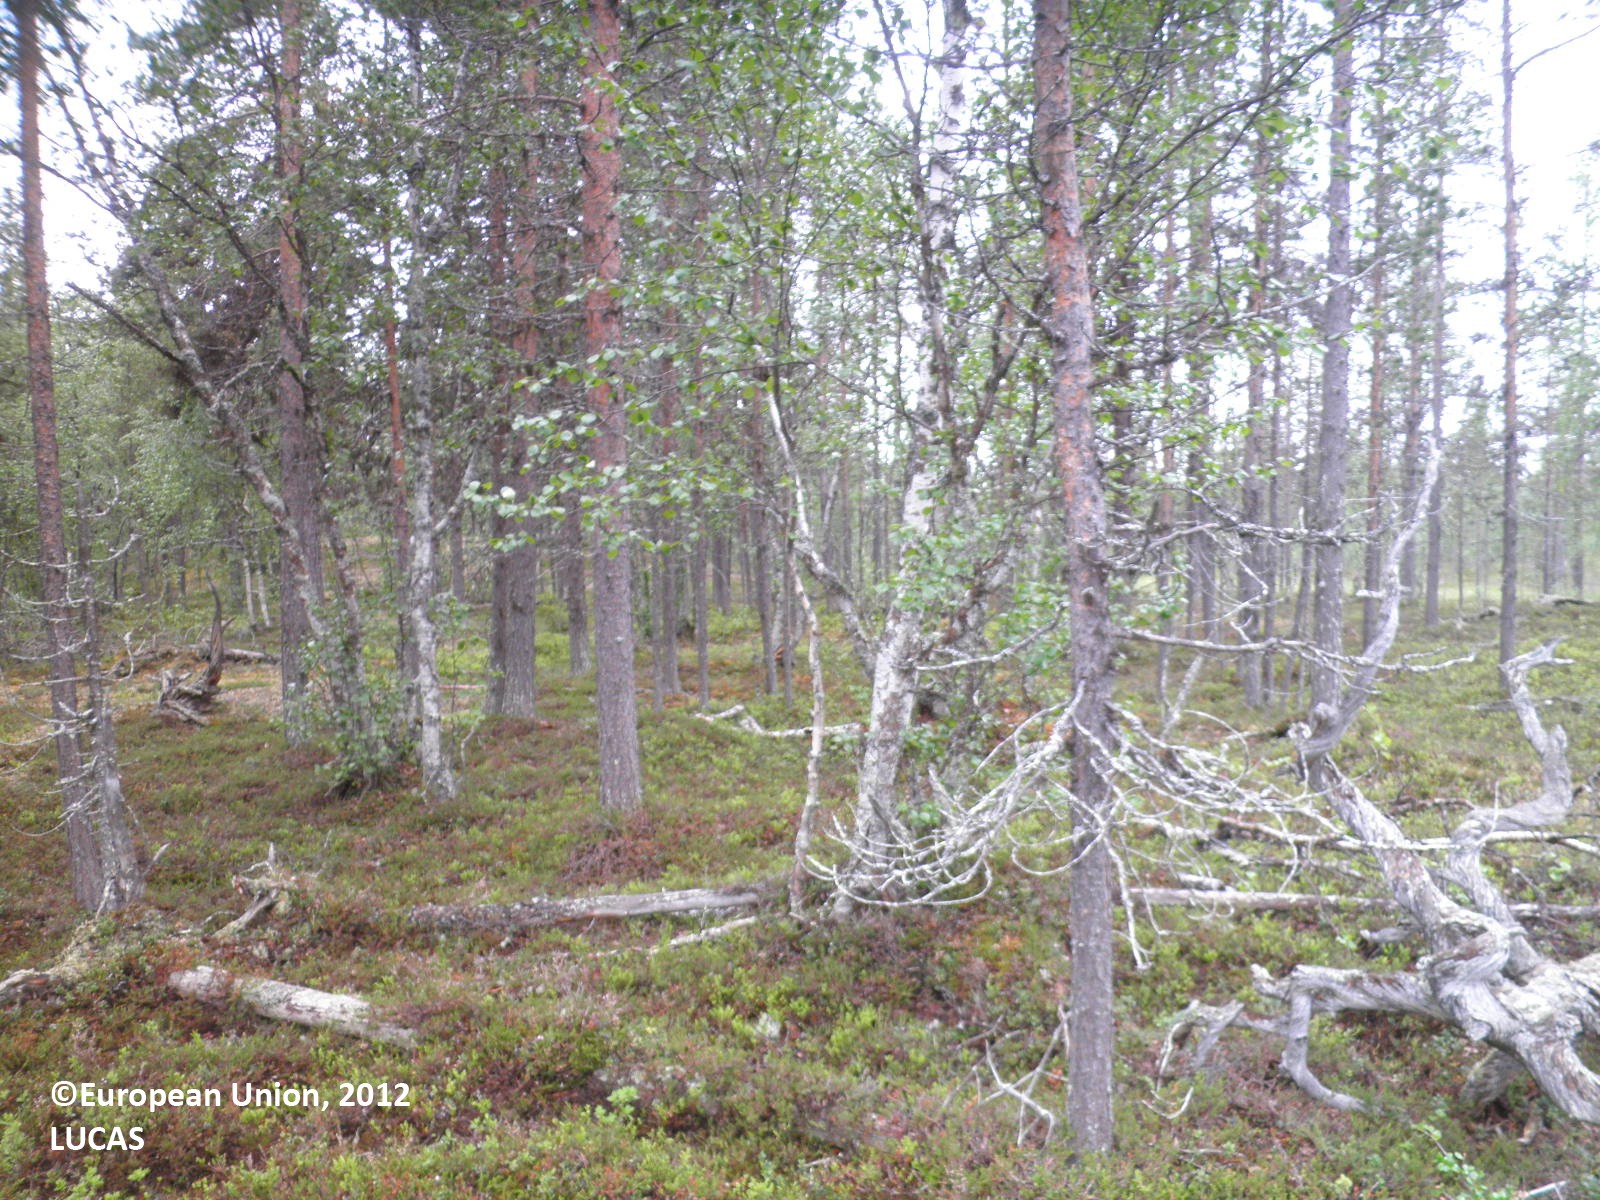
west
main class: Woodland
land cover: Pine dominated coniferous woodland
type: boreal forest
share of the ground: 50 - 75 %
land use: Forestry
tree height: > 5 m
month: July
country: FI
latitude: 68.2123
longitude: 25.6610
